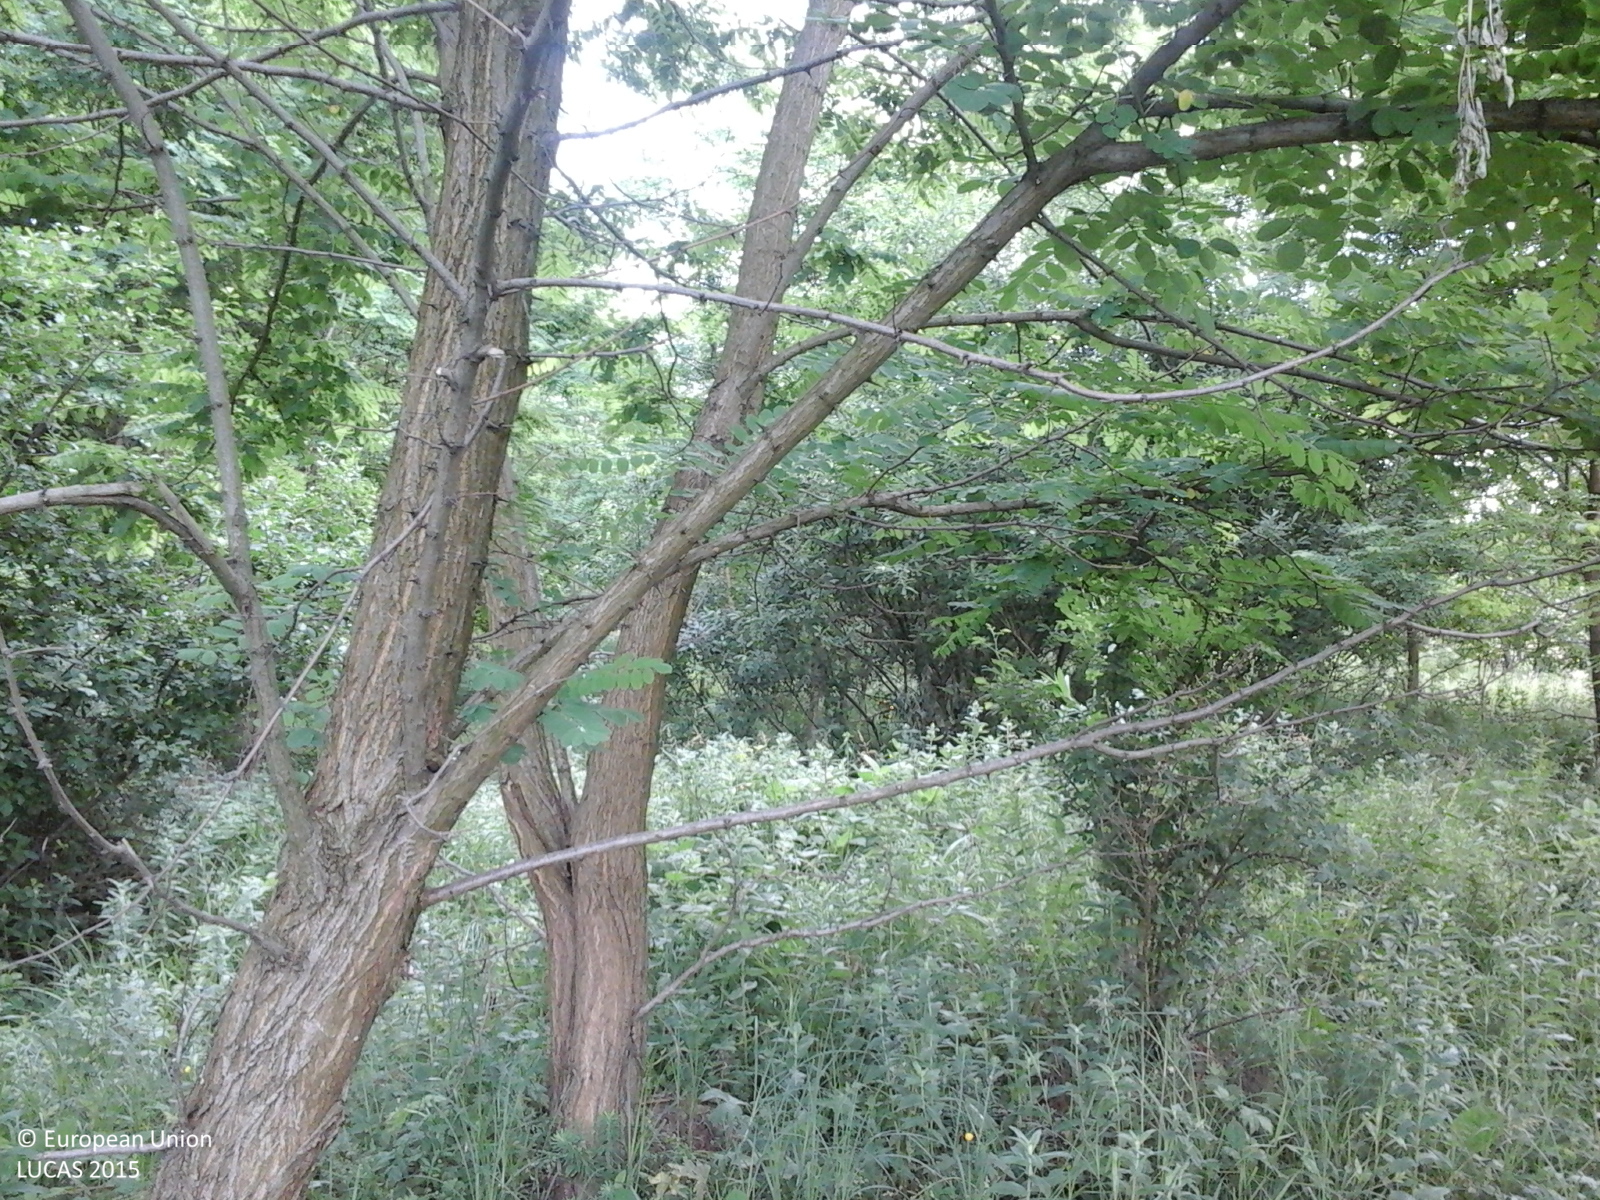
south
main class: Grassland
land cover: Grassland with sparse tree/shrub cover
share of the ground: > 75 %
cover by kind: herbaceous plants 90 %, broadleaved forest trees 5 %, shrubs 5 %
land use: Agriculture (excluding fallow land and kitchen gardens)
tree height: > 5 m
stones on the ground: < 10 %
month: June
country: RO
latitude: 47.4417
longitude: 26.4098
